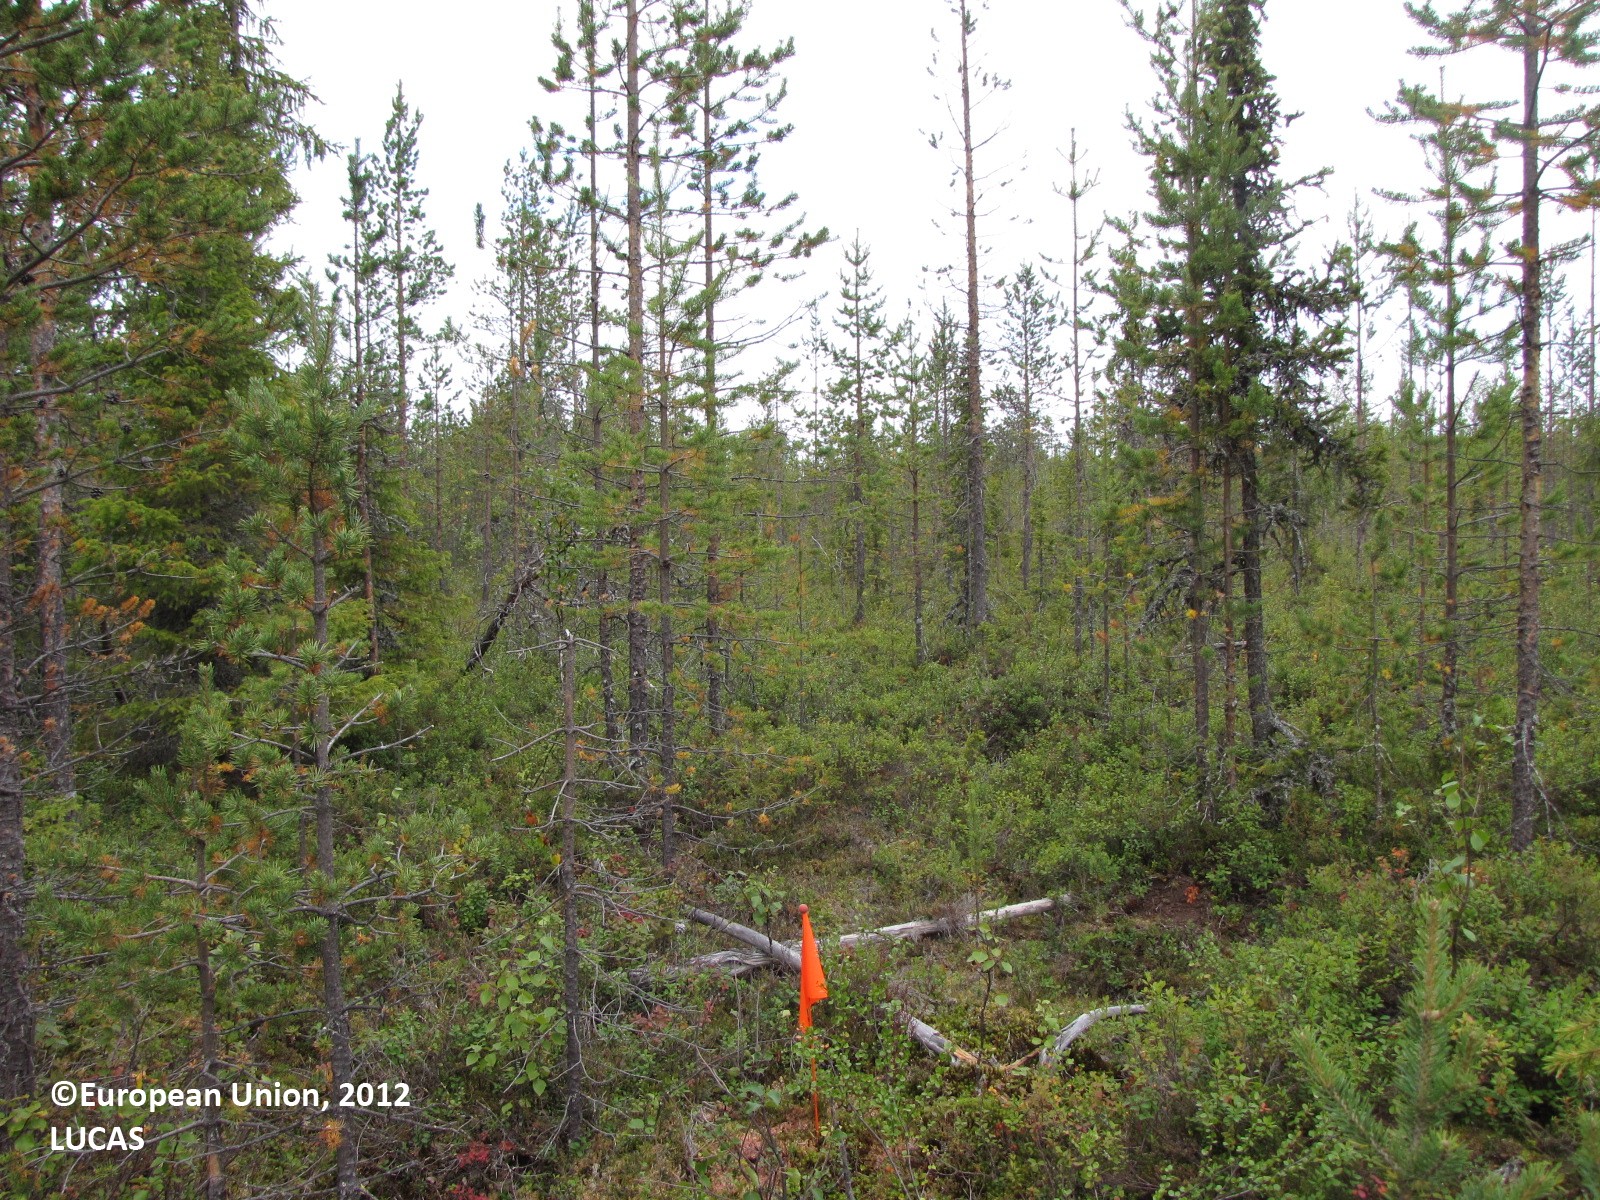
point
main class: Woodland
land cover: Other coniferous woodland
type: boreal forest
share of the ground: 25 - 50 %
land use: Forestry
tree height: > 5 m
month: August
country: FI
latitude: 67.1205
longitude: 25.1917
